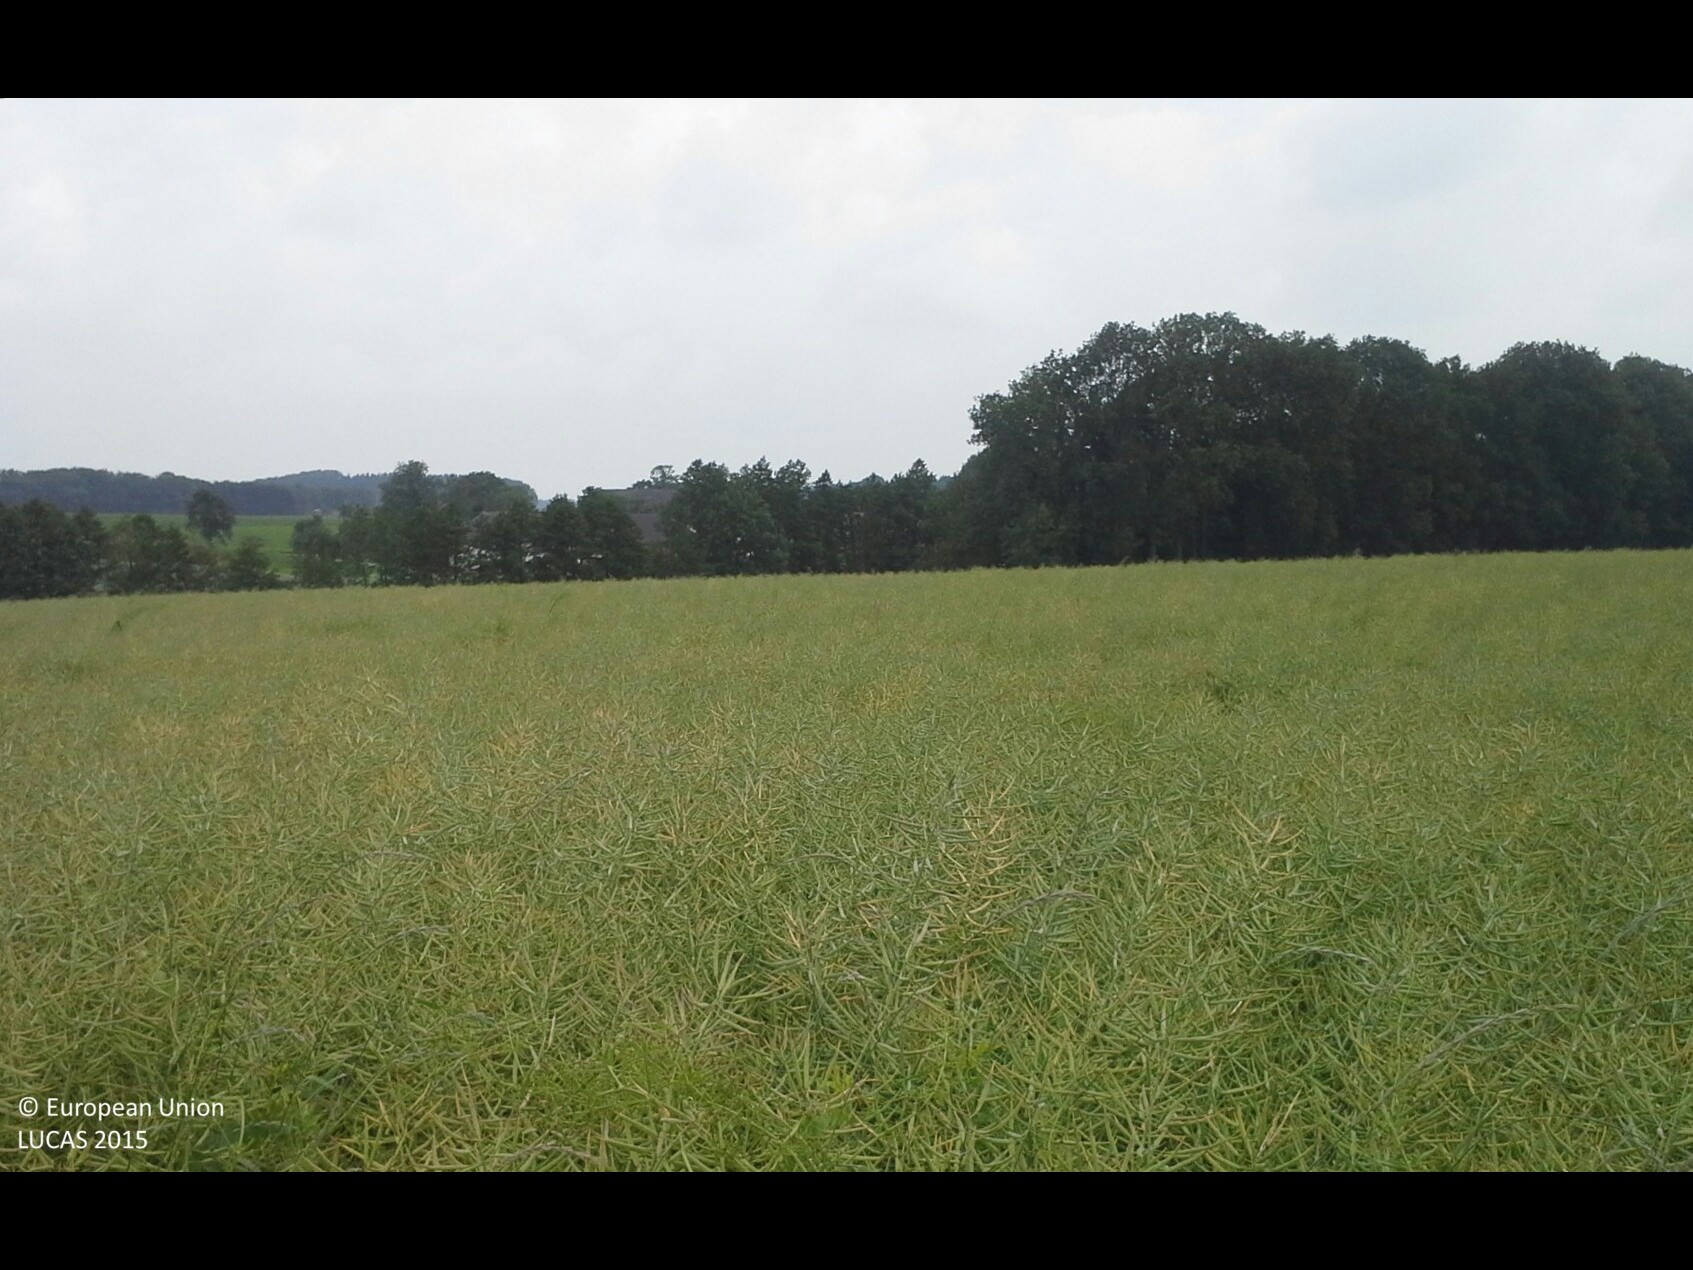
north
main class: Cropland
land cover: Rape and turnip rape
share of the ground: > 75 %
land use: Agriculture (excluding fallow land and kitchen gardens)
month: June
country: AT
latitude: 48.1022
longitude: 14.3375
